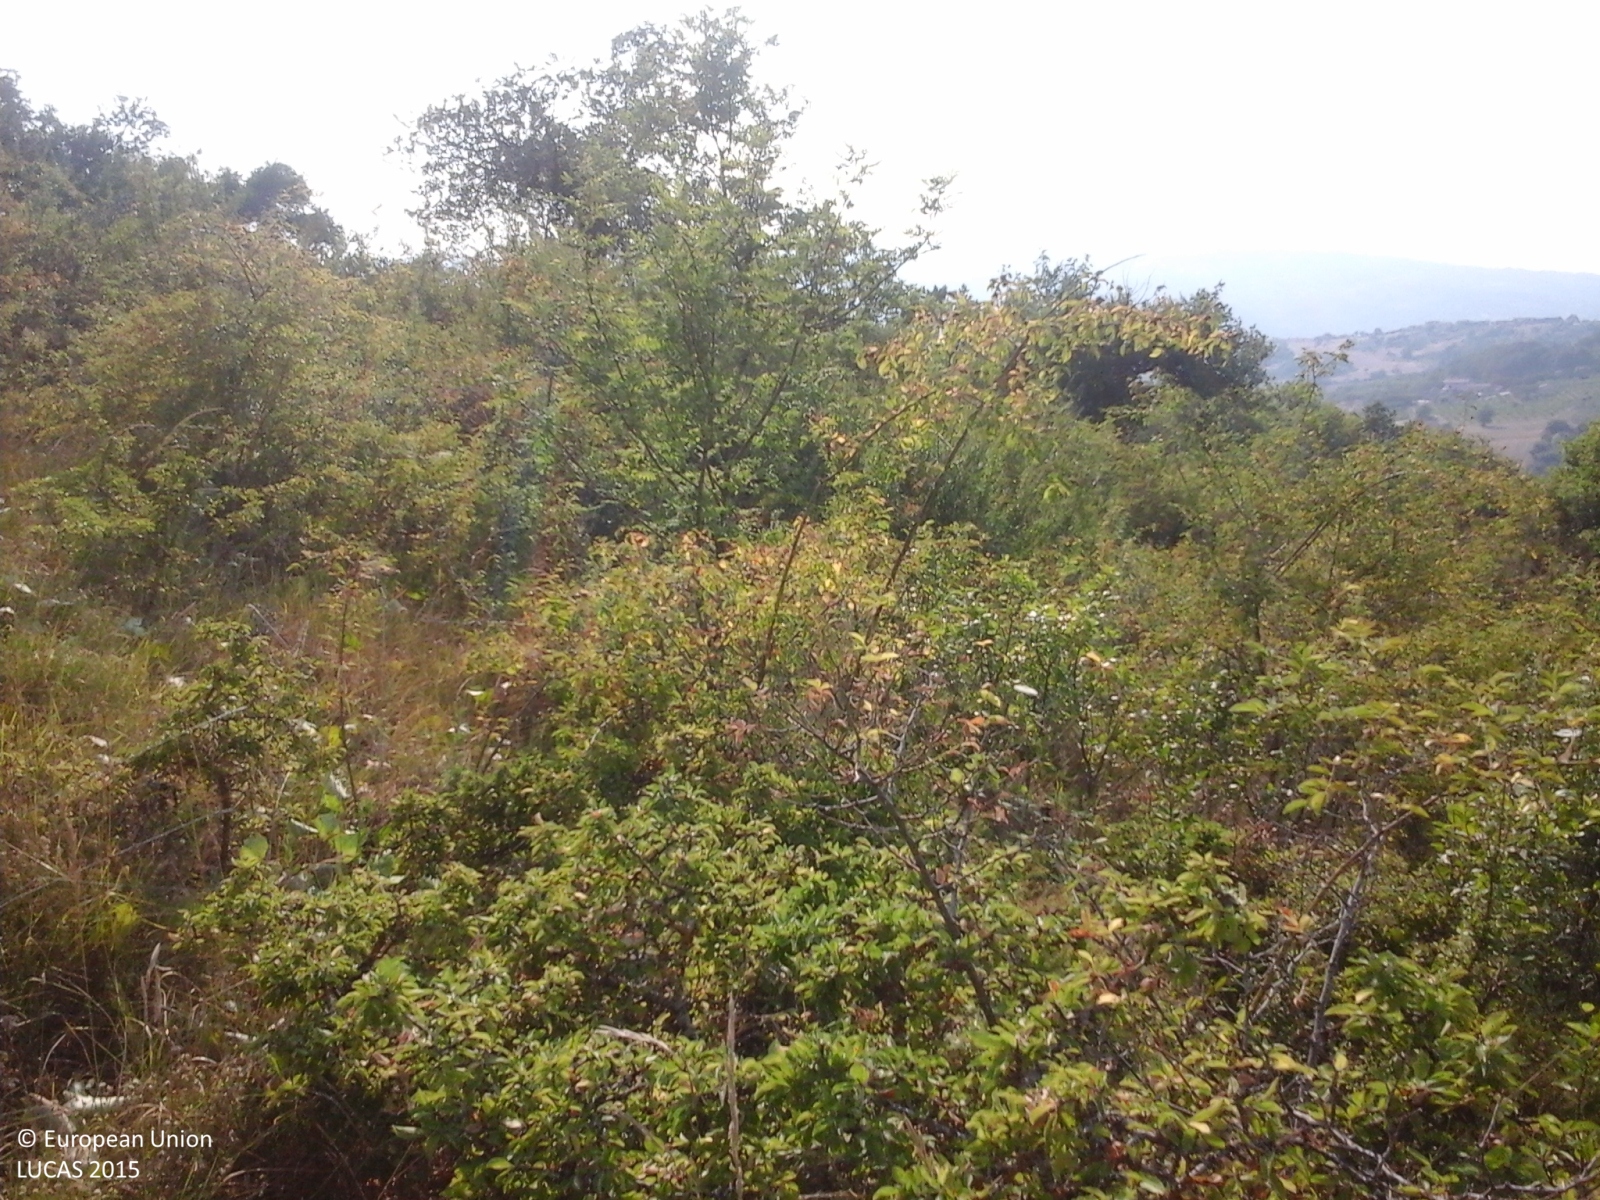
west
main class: Woodland
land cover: Broadleaved woodland
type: thermophilous deciduous forest
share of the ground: > 75 %
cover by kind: broadleaved forest trees 70 %, shrubs 25 %, herbaceous plants 5 %
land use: Forestry
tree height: > 5 m
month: July
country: IT
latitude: 40.8974
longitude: 15.0725
